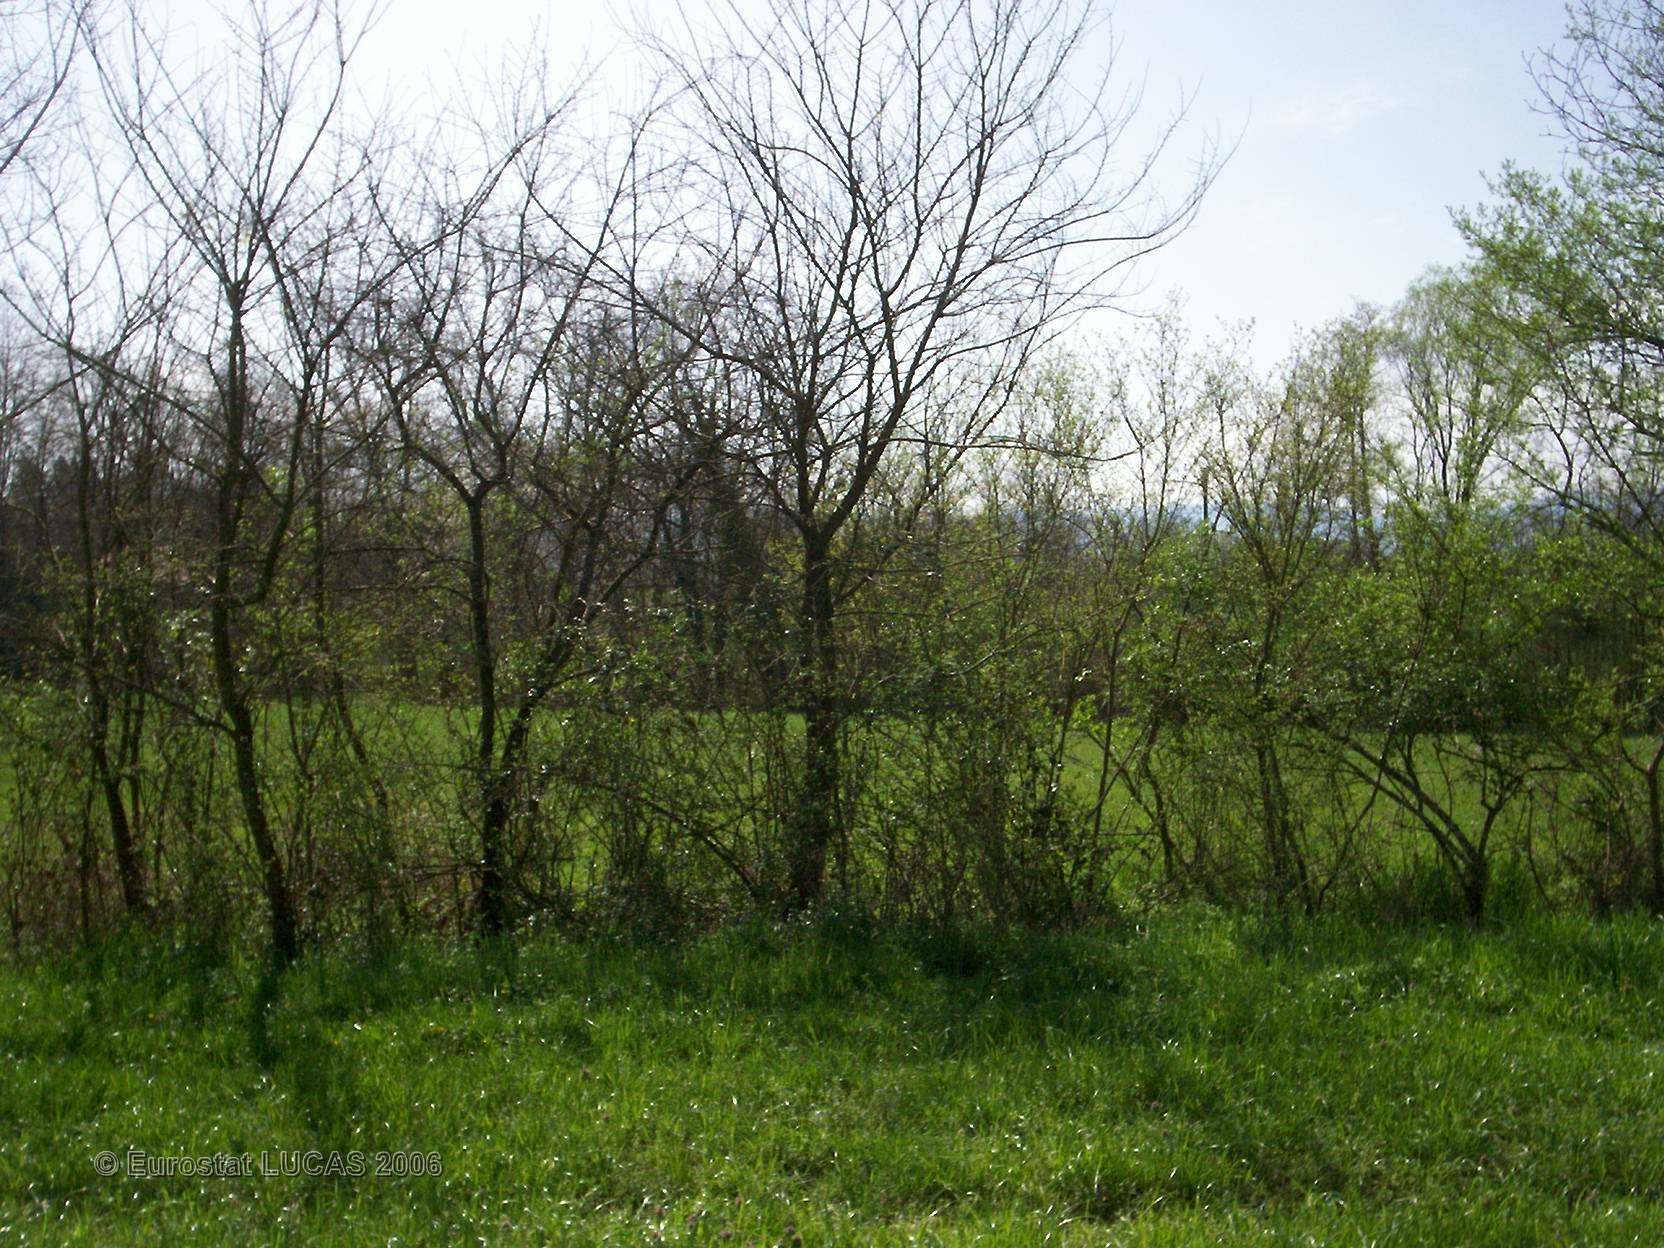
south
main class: Grassland
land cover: Grassland without tree/shrub cover
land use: Agriculture (excluding fallow land and kitchen gardens)
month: April
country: FR
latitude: 43.1350
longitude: 0.9177
